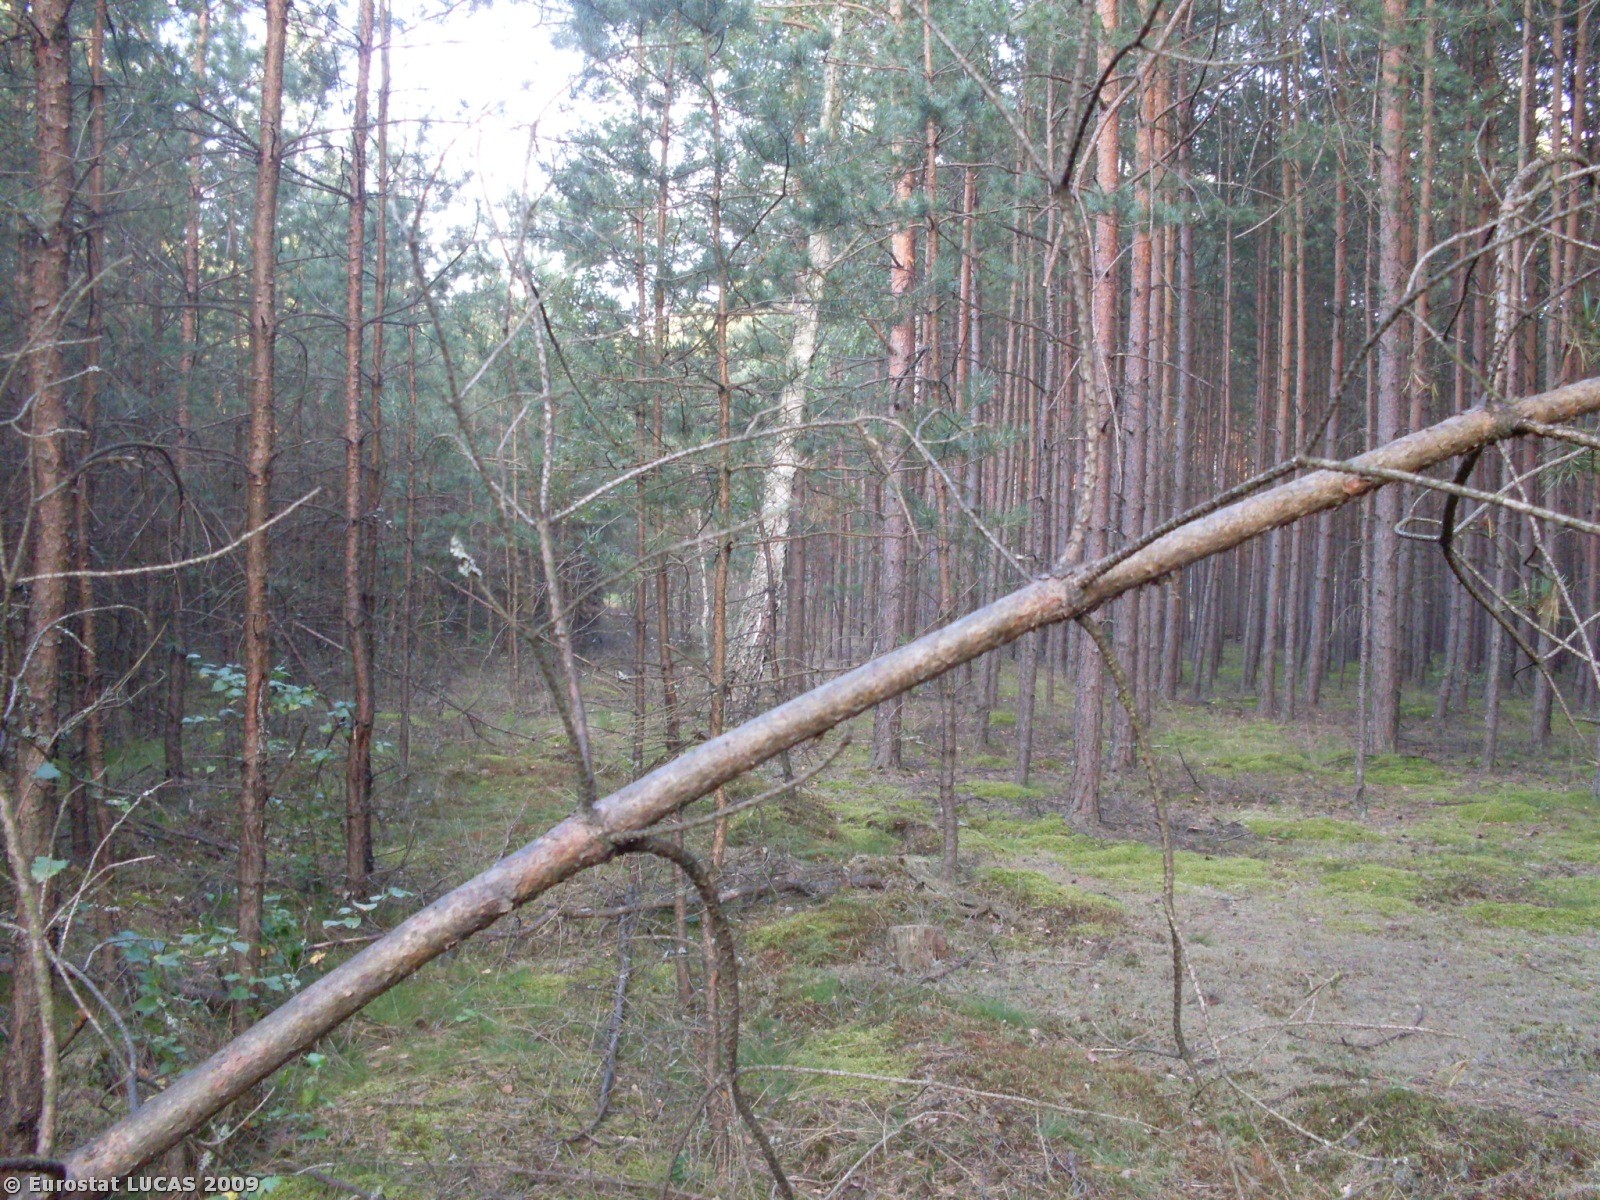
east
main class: Woodland
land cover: Coniferous woodland
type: hemiboreal forest and nemoral coniferous forest and mixed broadleaved-coniferous forest
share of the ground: > 75 %
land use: Forestry
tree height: > 5 m
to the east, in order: Coniferous woodland; Grass margins; Tracks; Grass margins; Coniferous woodland
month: August
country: PL
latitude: 53.0943
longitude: 15.9334
